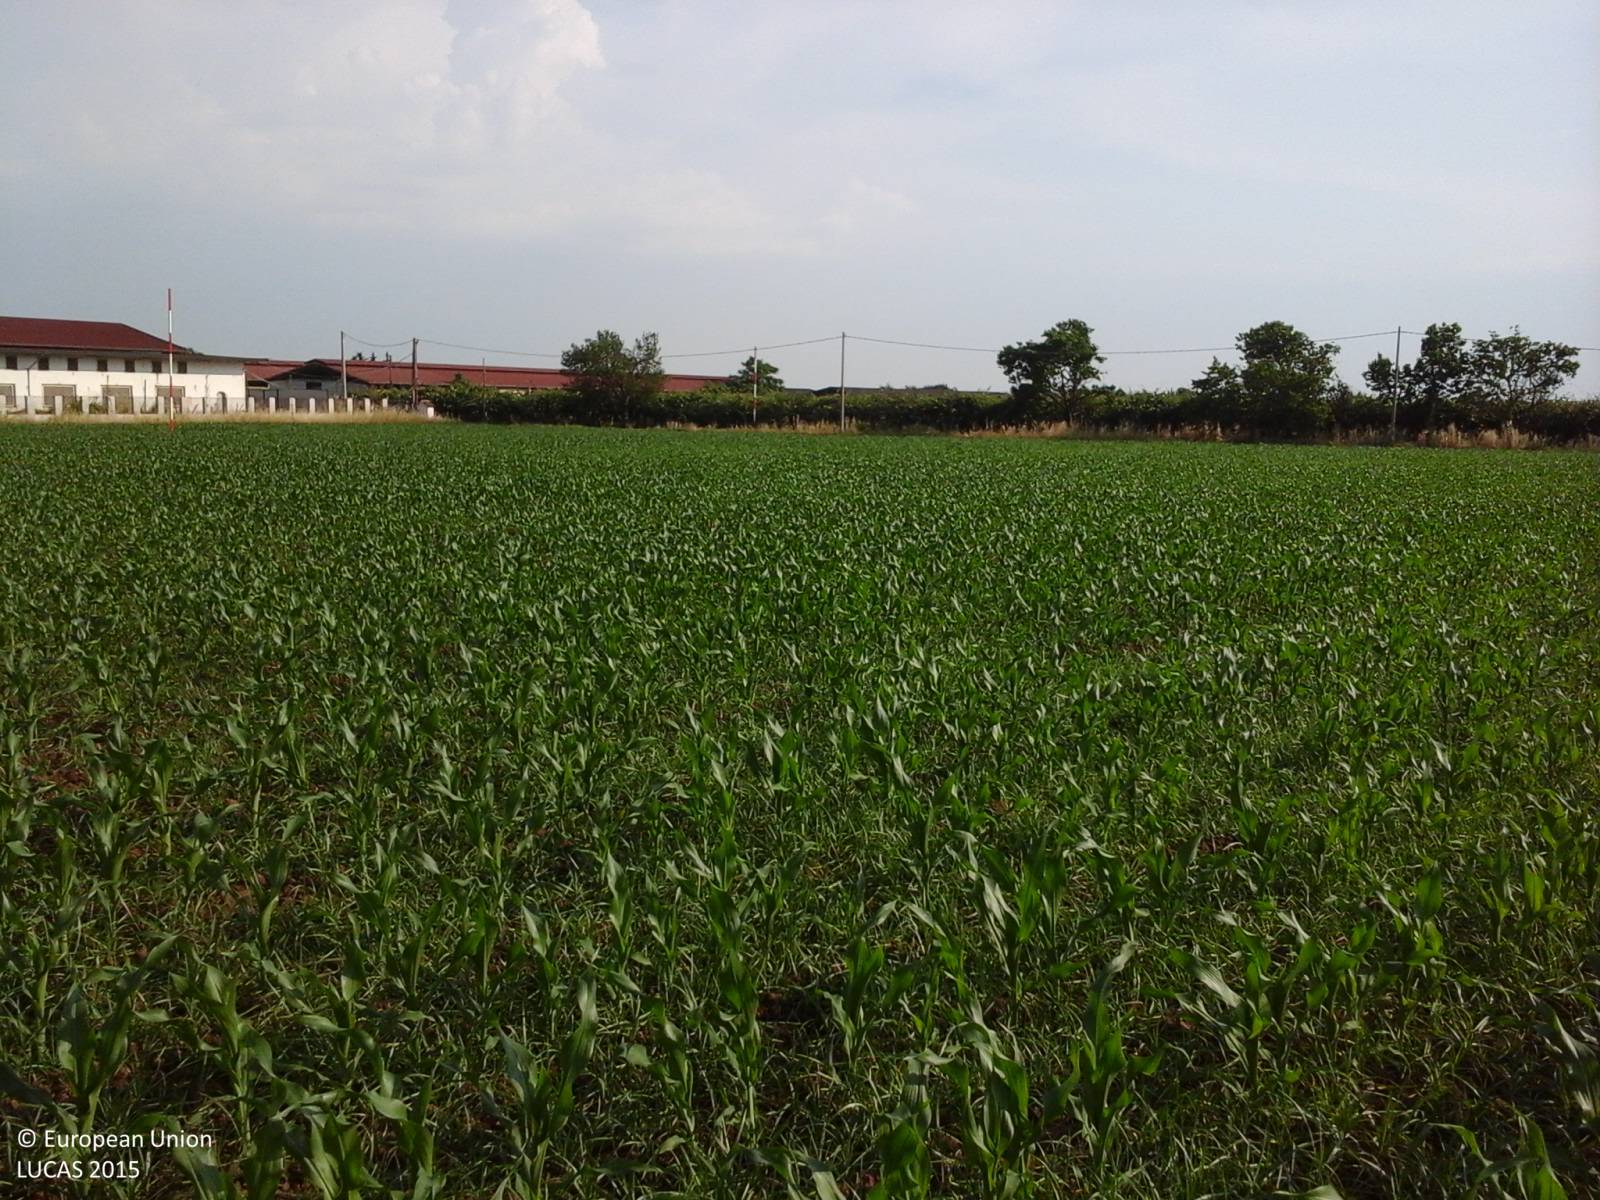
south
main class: Cropland
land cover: Maize
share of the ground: 25 - 50 %
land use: Agriculture (excluding fallow land and kitchen gardens)
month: June
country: IT
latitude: 41.1941
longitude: 14.1450
